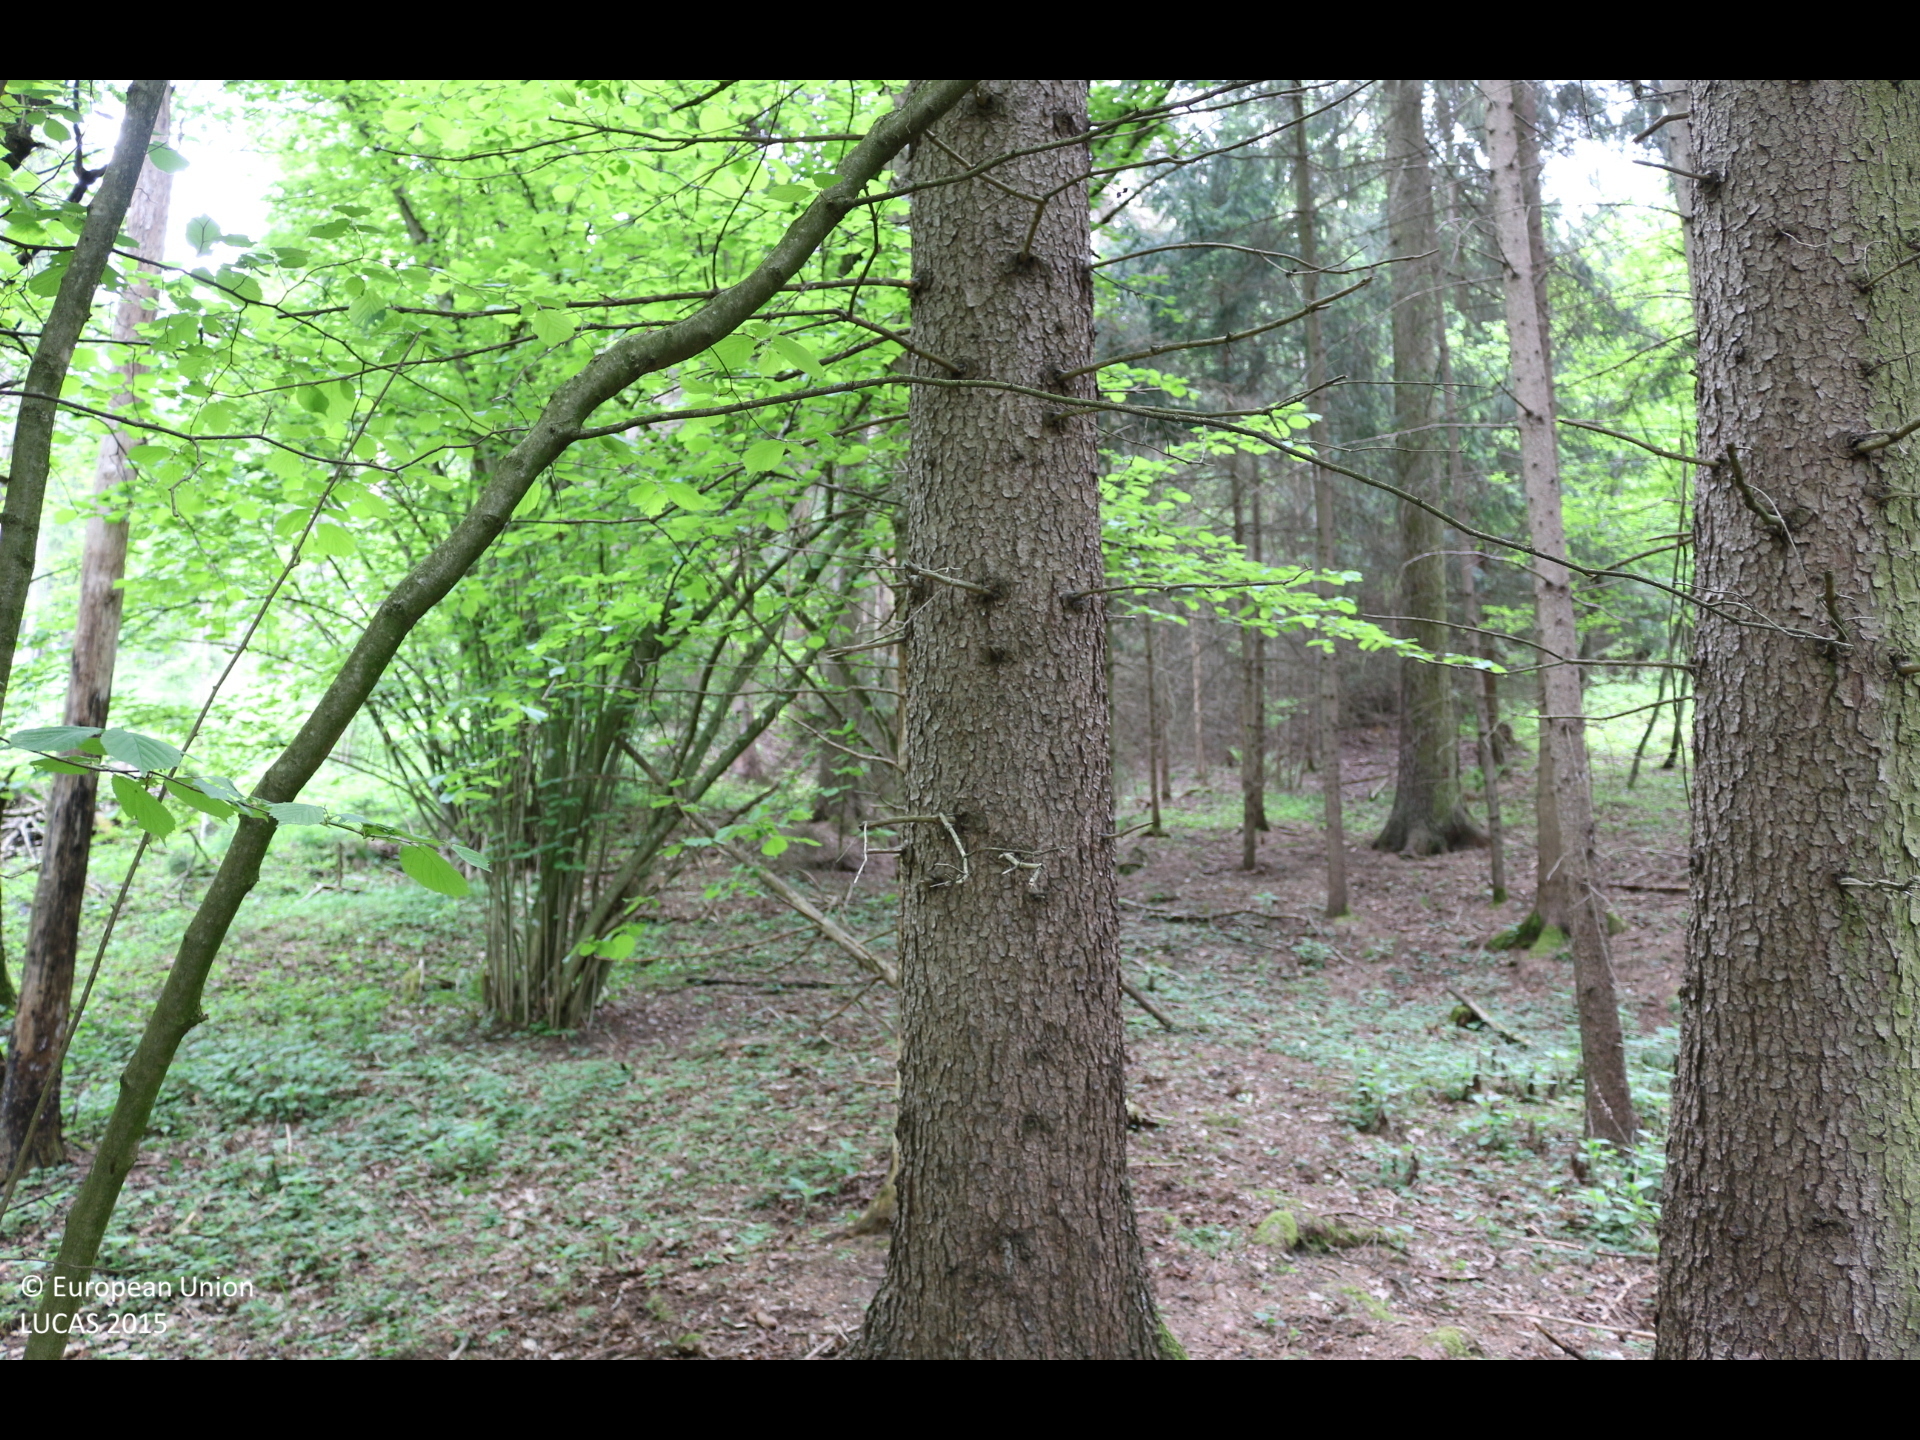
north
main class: Woodland
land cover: Spruce dominated mixed woodland
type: alpine coniferous forest
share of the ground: > 75 %
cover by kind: coniferous forest trees 60 %, broadleaved forest trees 40 %
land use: Forestry
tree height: > 5 m
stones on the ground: < 10 %
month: May
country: AT
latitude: 46.6606
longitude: 14.3233
